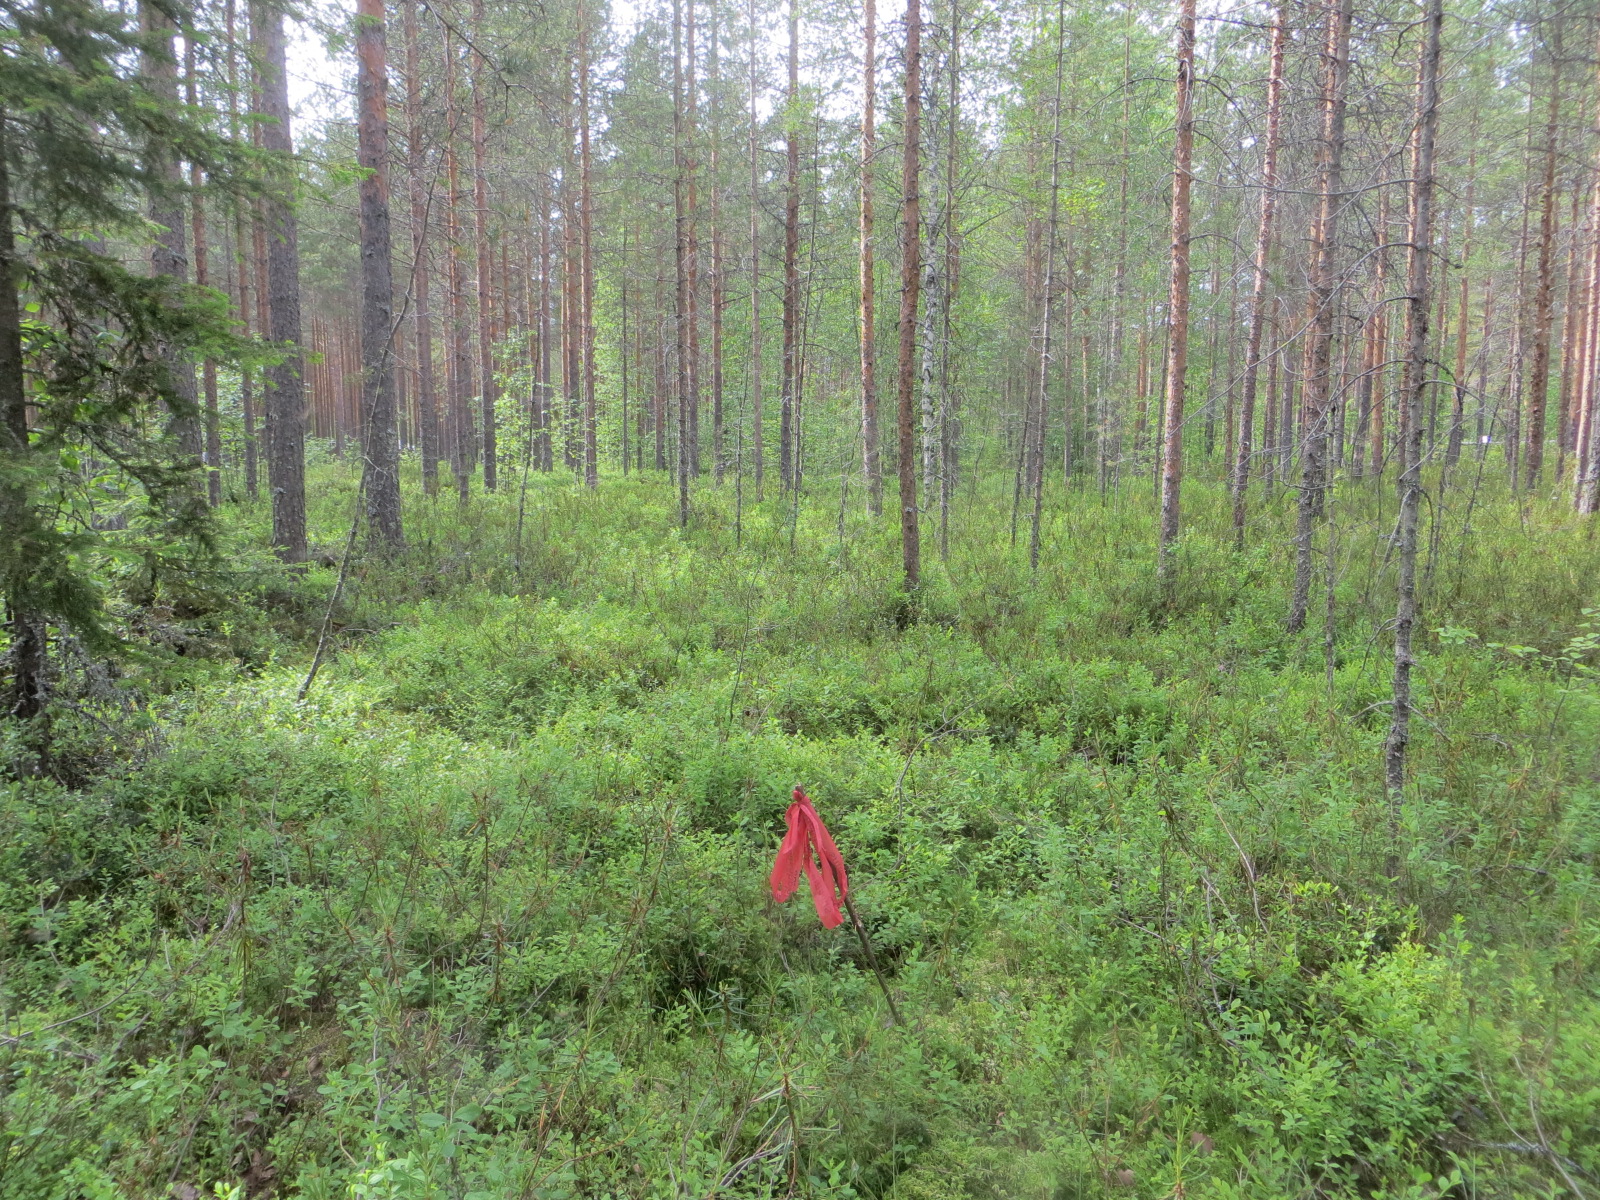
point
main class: Woodland
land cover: Pine dominated coniferous woodland
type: boreal forest
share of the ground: 50 - 75 %
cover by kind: coniferous forest trees 65 %, shrubs 30 %, broadleaved forest trees 5 %
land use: Forestry
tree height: > 5 m
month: July
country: FI
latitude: 65.3676
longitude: 25.8924
